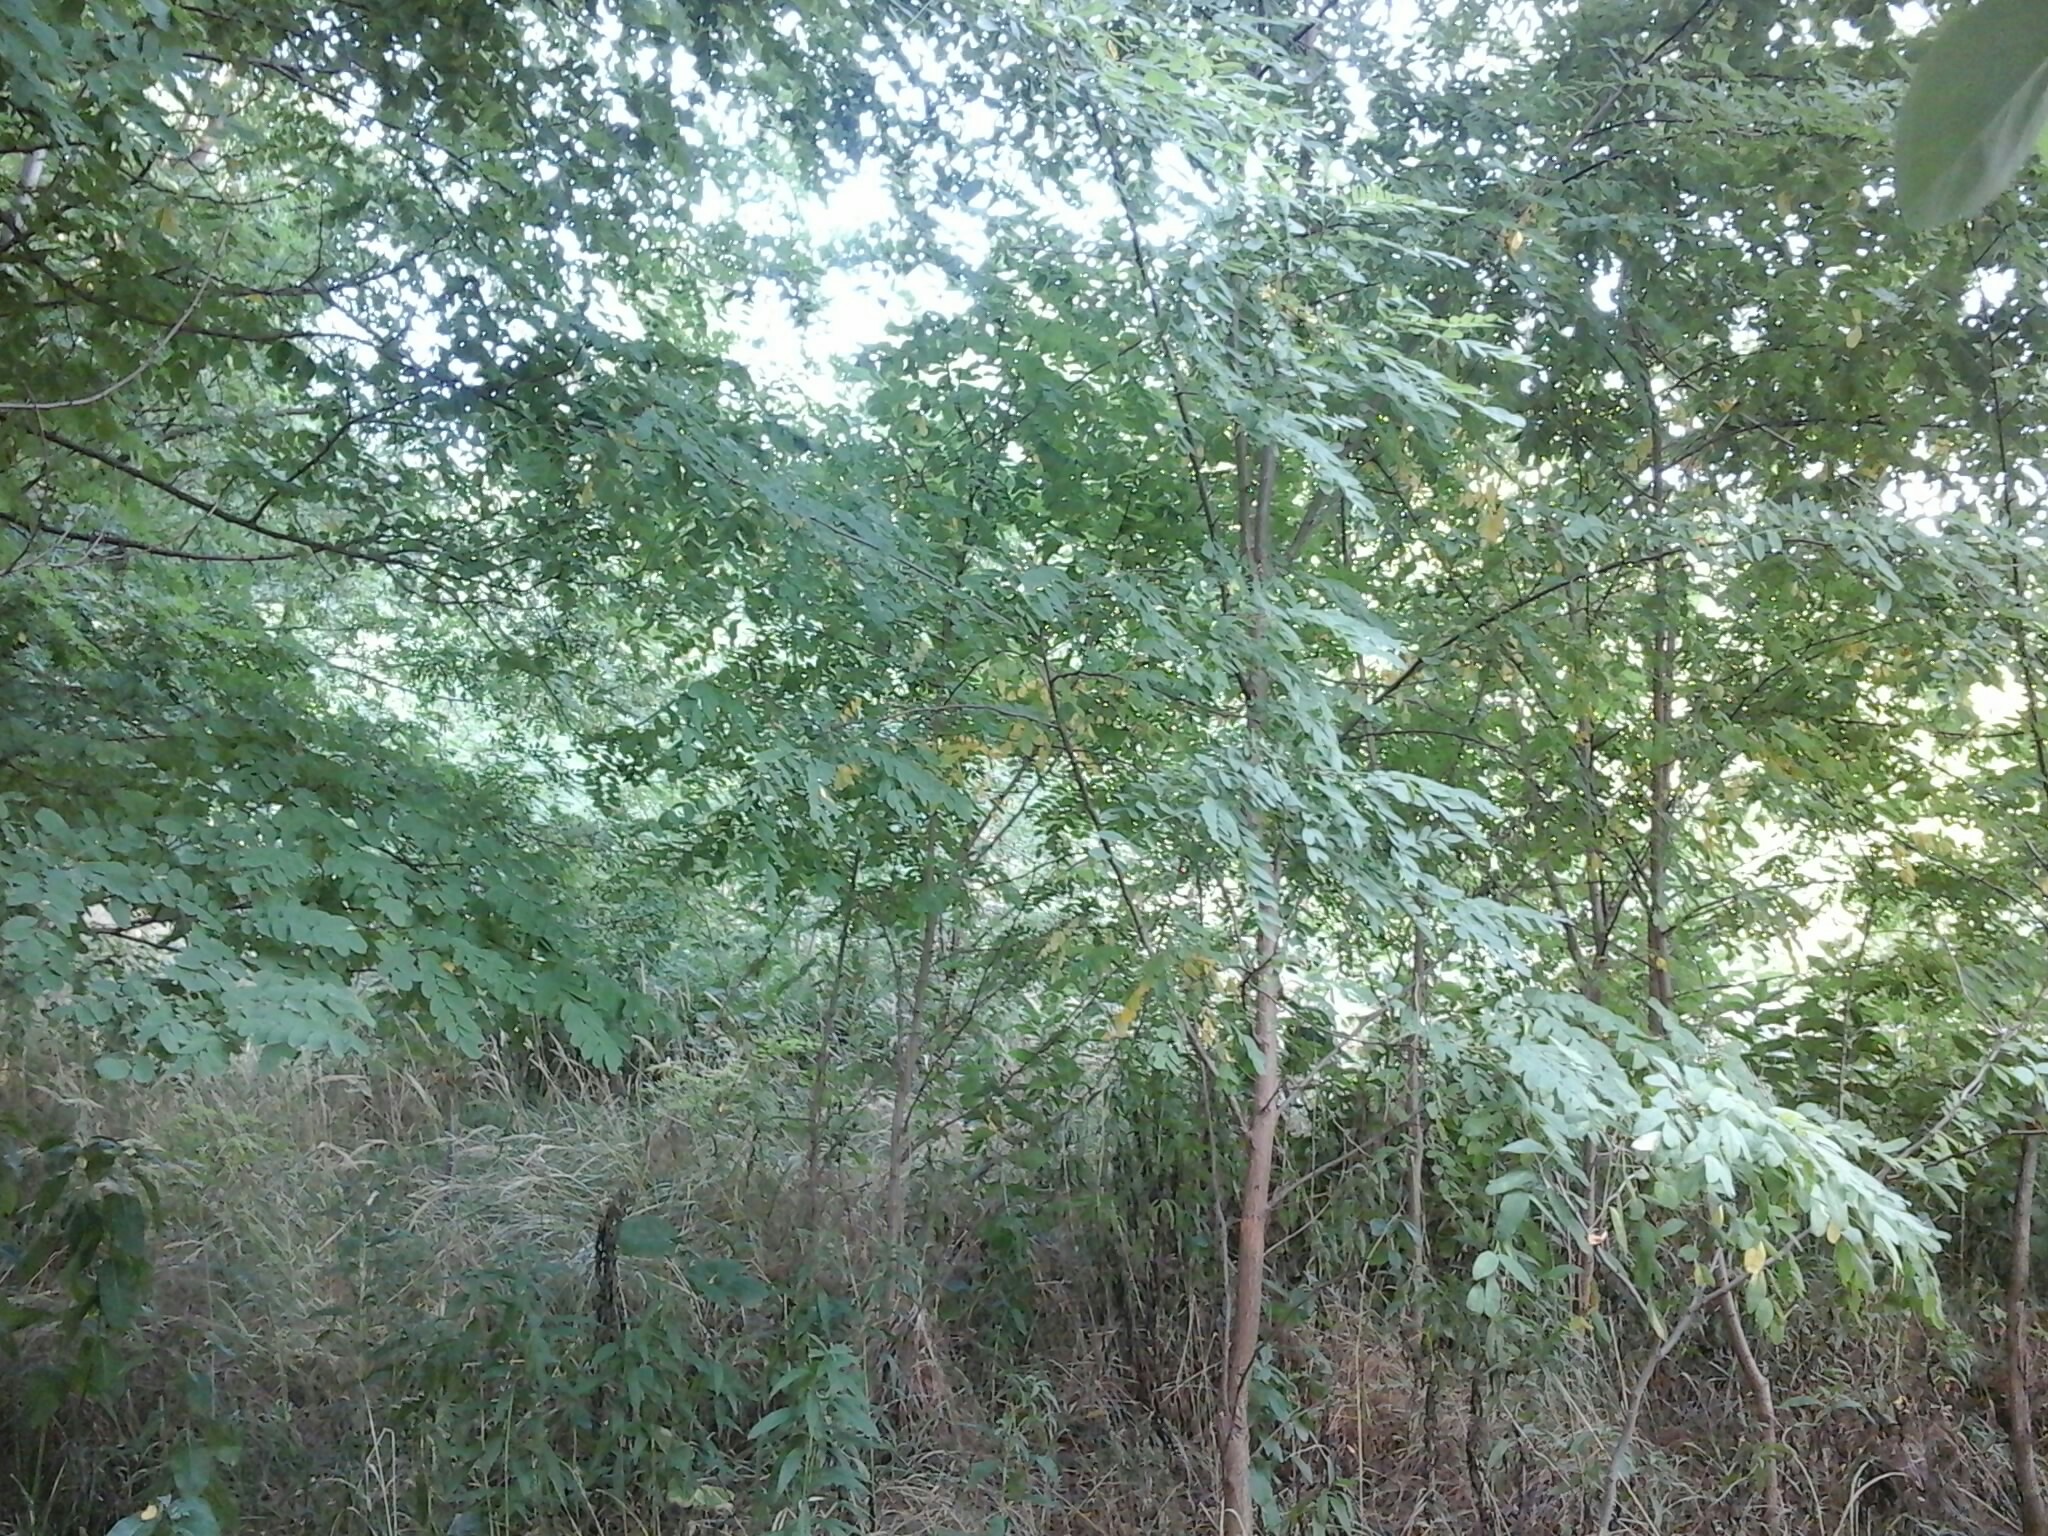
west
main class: Woodland
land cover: Broadleaved woodland
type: exotic forest
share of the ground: > 75 %
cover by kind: broadleaved forest trees 95 %, herbaceous plants 5 %
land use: Forestry
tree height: > 5 m
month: August
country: HU
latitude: 47.5230
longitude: 17.9125
